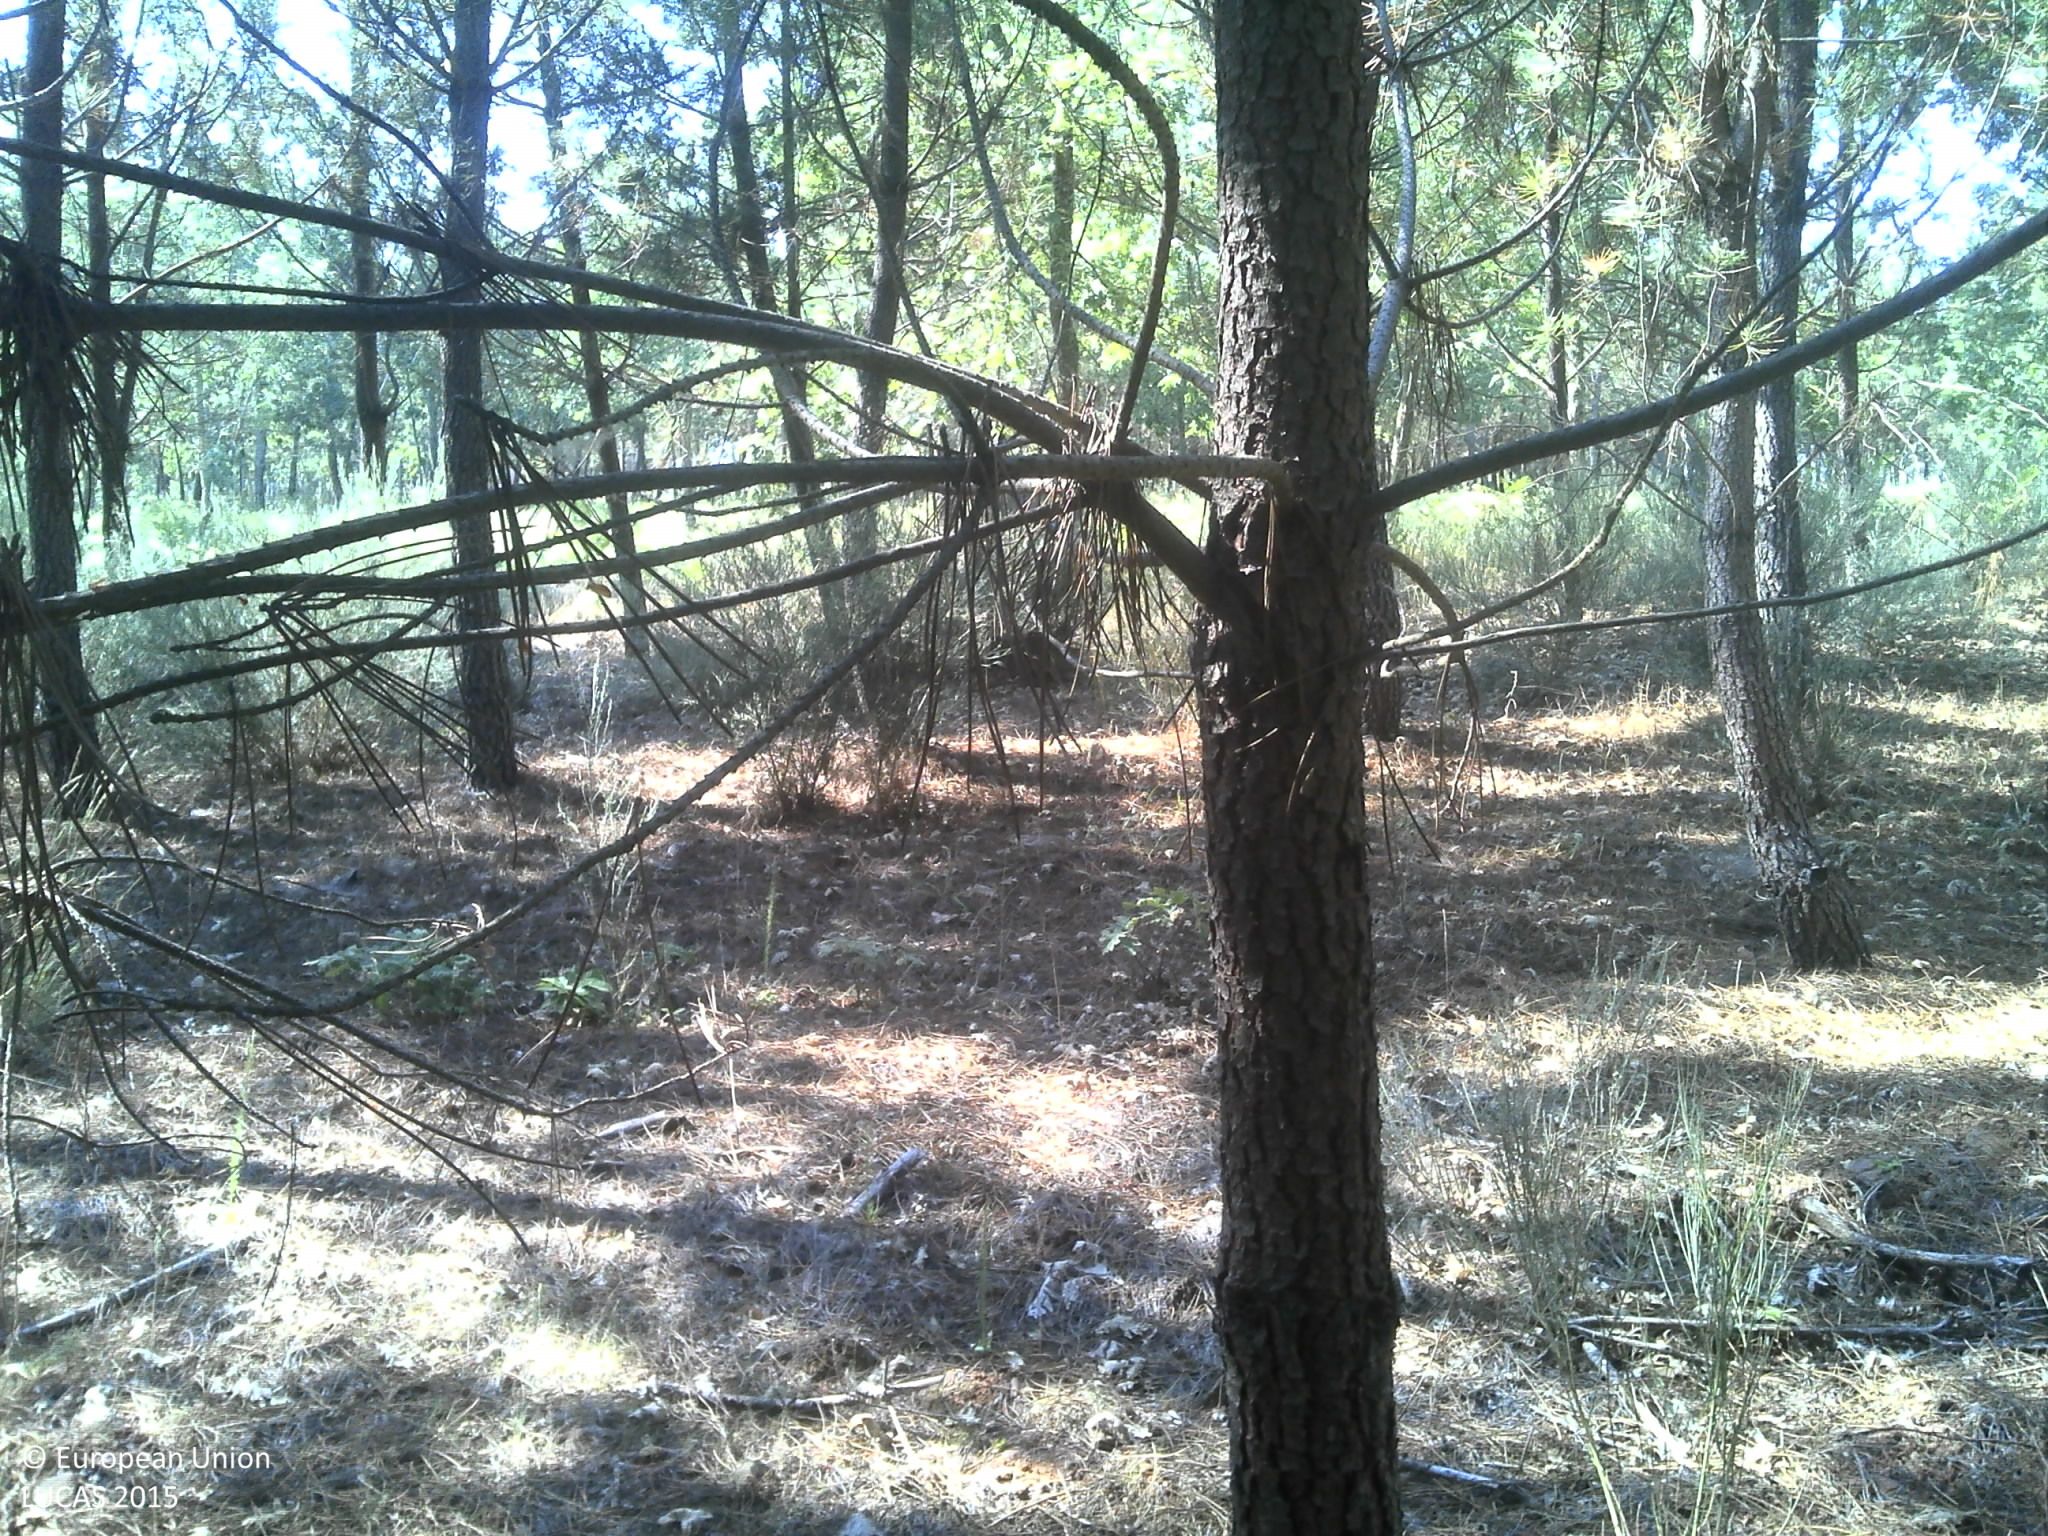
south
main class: Woodland
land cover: Pine dominated coniferous woodland
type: coniferous forest of the mediterranean region
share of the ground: 50 - 75 %
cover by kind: coniferous forest trees 75 %, unconsolidated bare surface 20 %, herbaceous plants 5 %
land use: Forestry
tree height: > 5 m
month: June
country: PT
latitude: 40.3798
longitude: -6.9752
